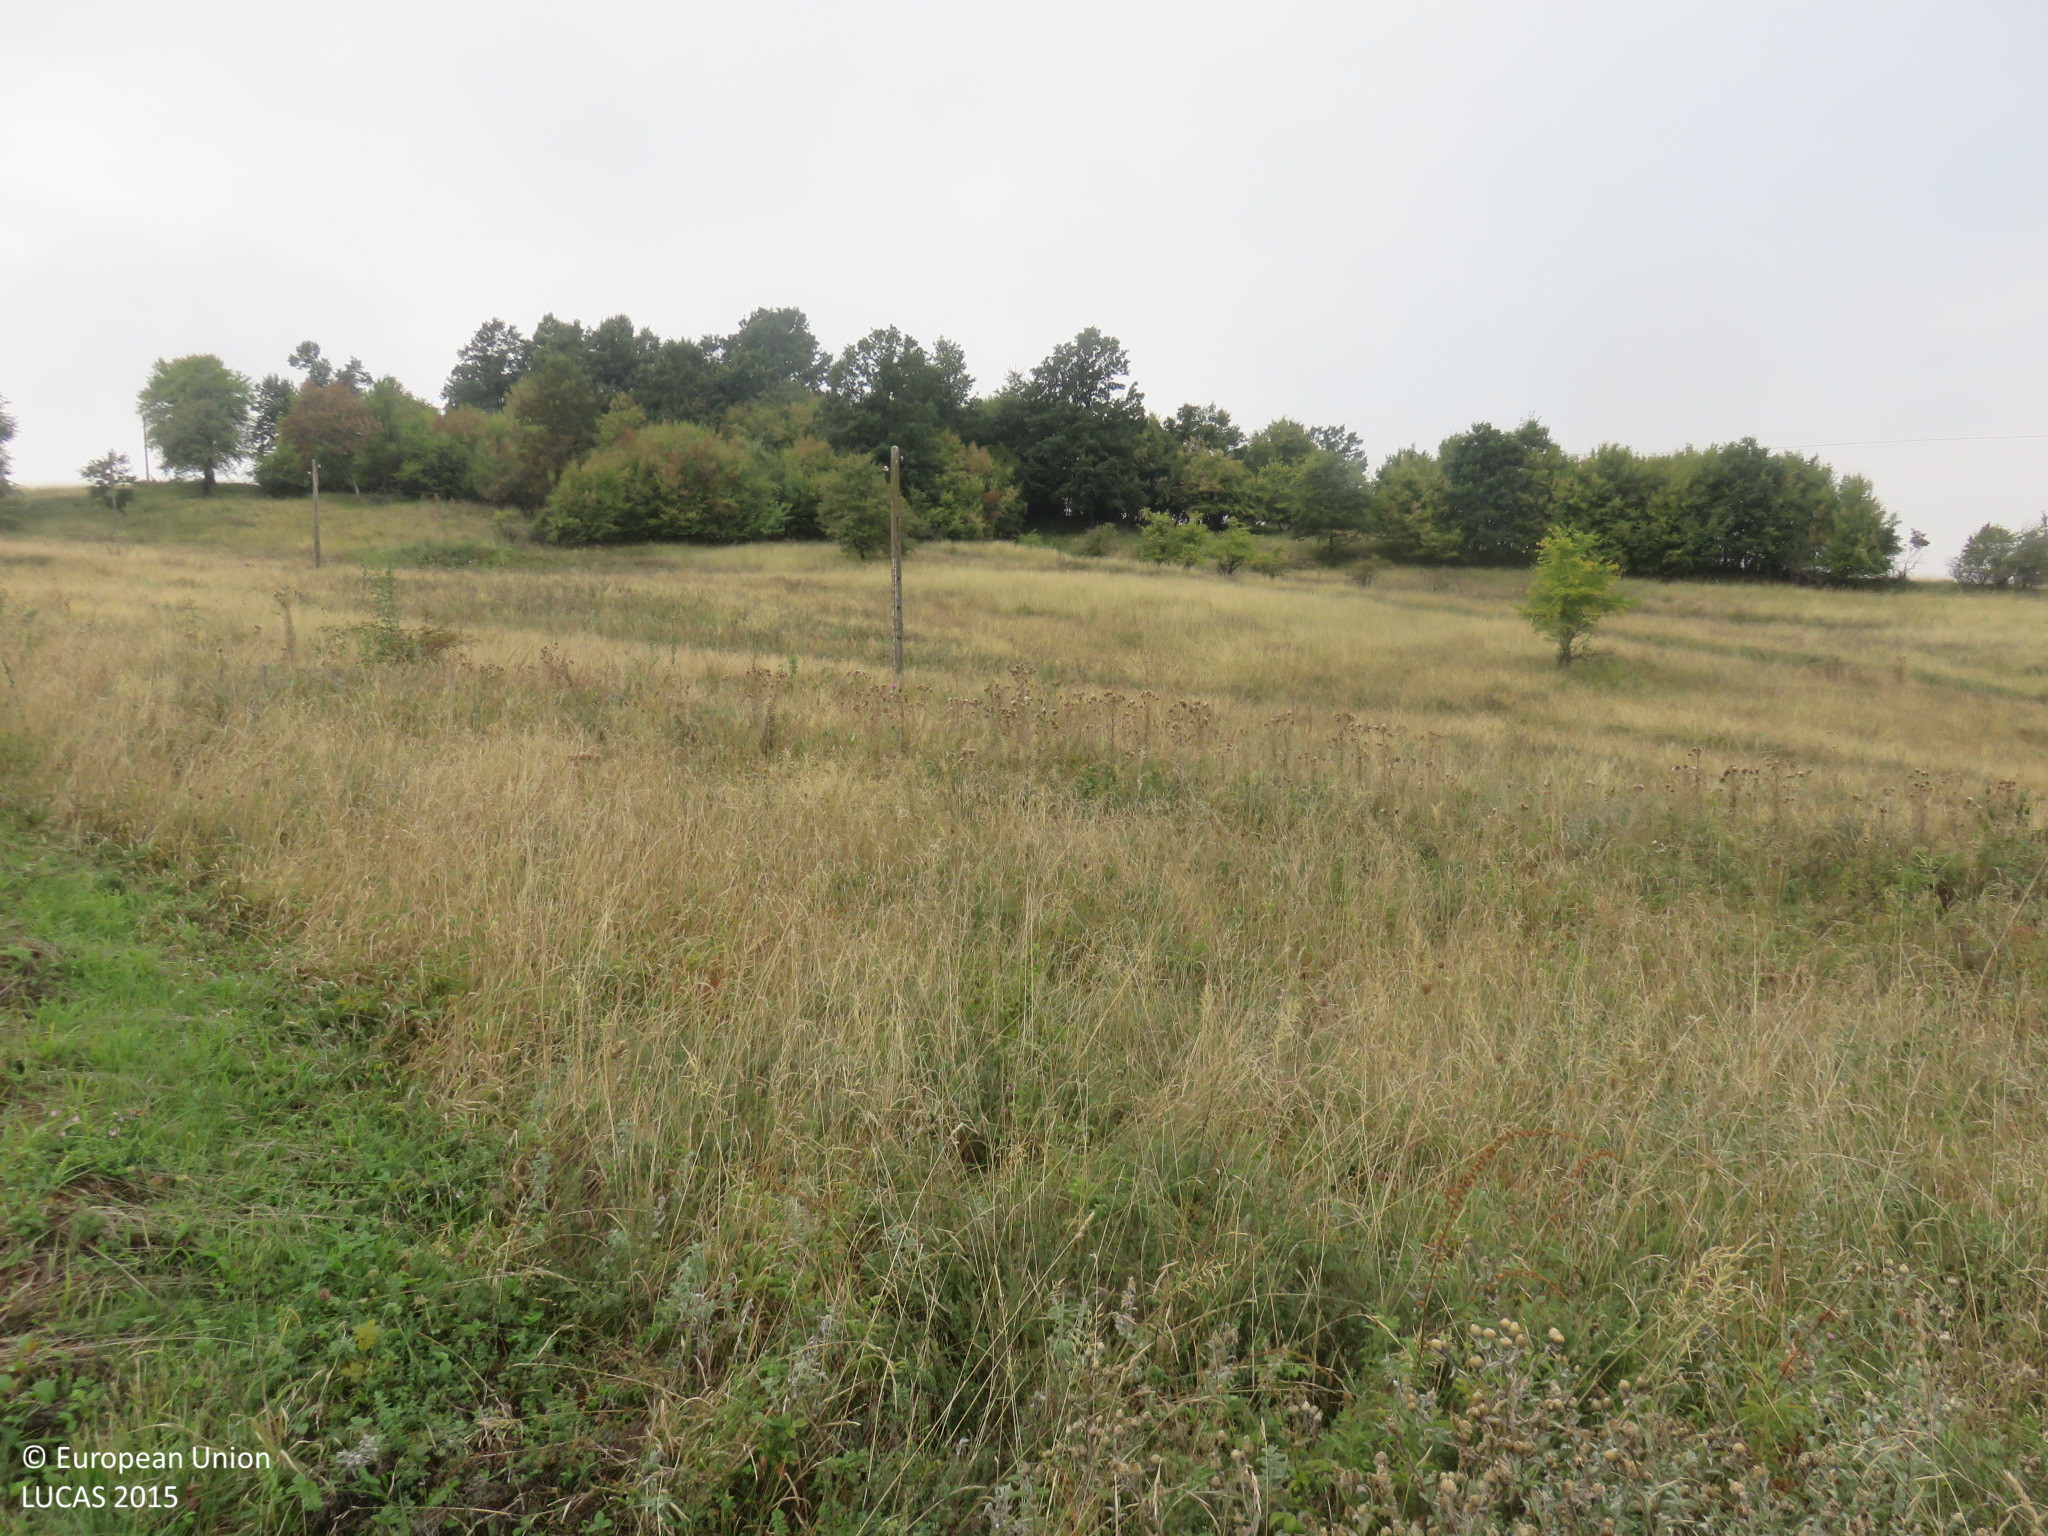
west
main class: Grassland
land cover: Grassland without tree/shrub cover
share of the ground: > 75 %
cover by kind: herbaceous plants 100 %
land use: Agriculture (excluding fallow land and kitchen gardens)
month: September
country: BG
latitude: 43.1141
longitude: 24.8234
